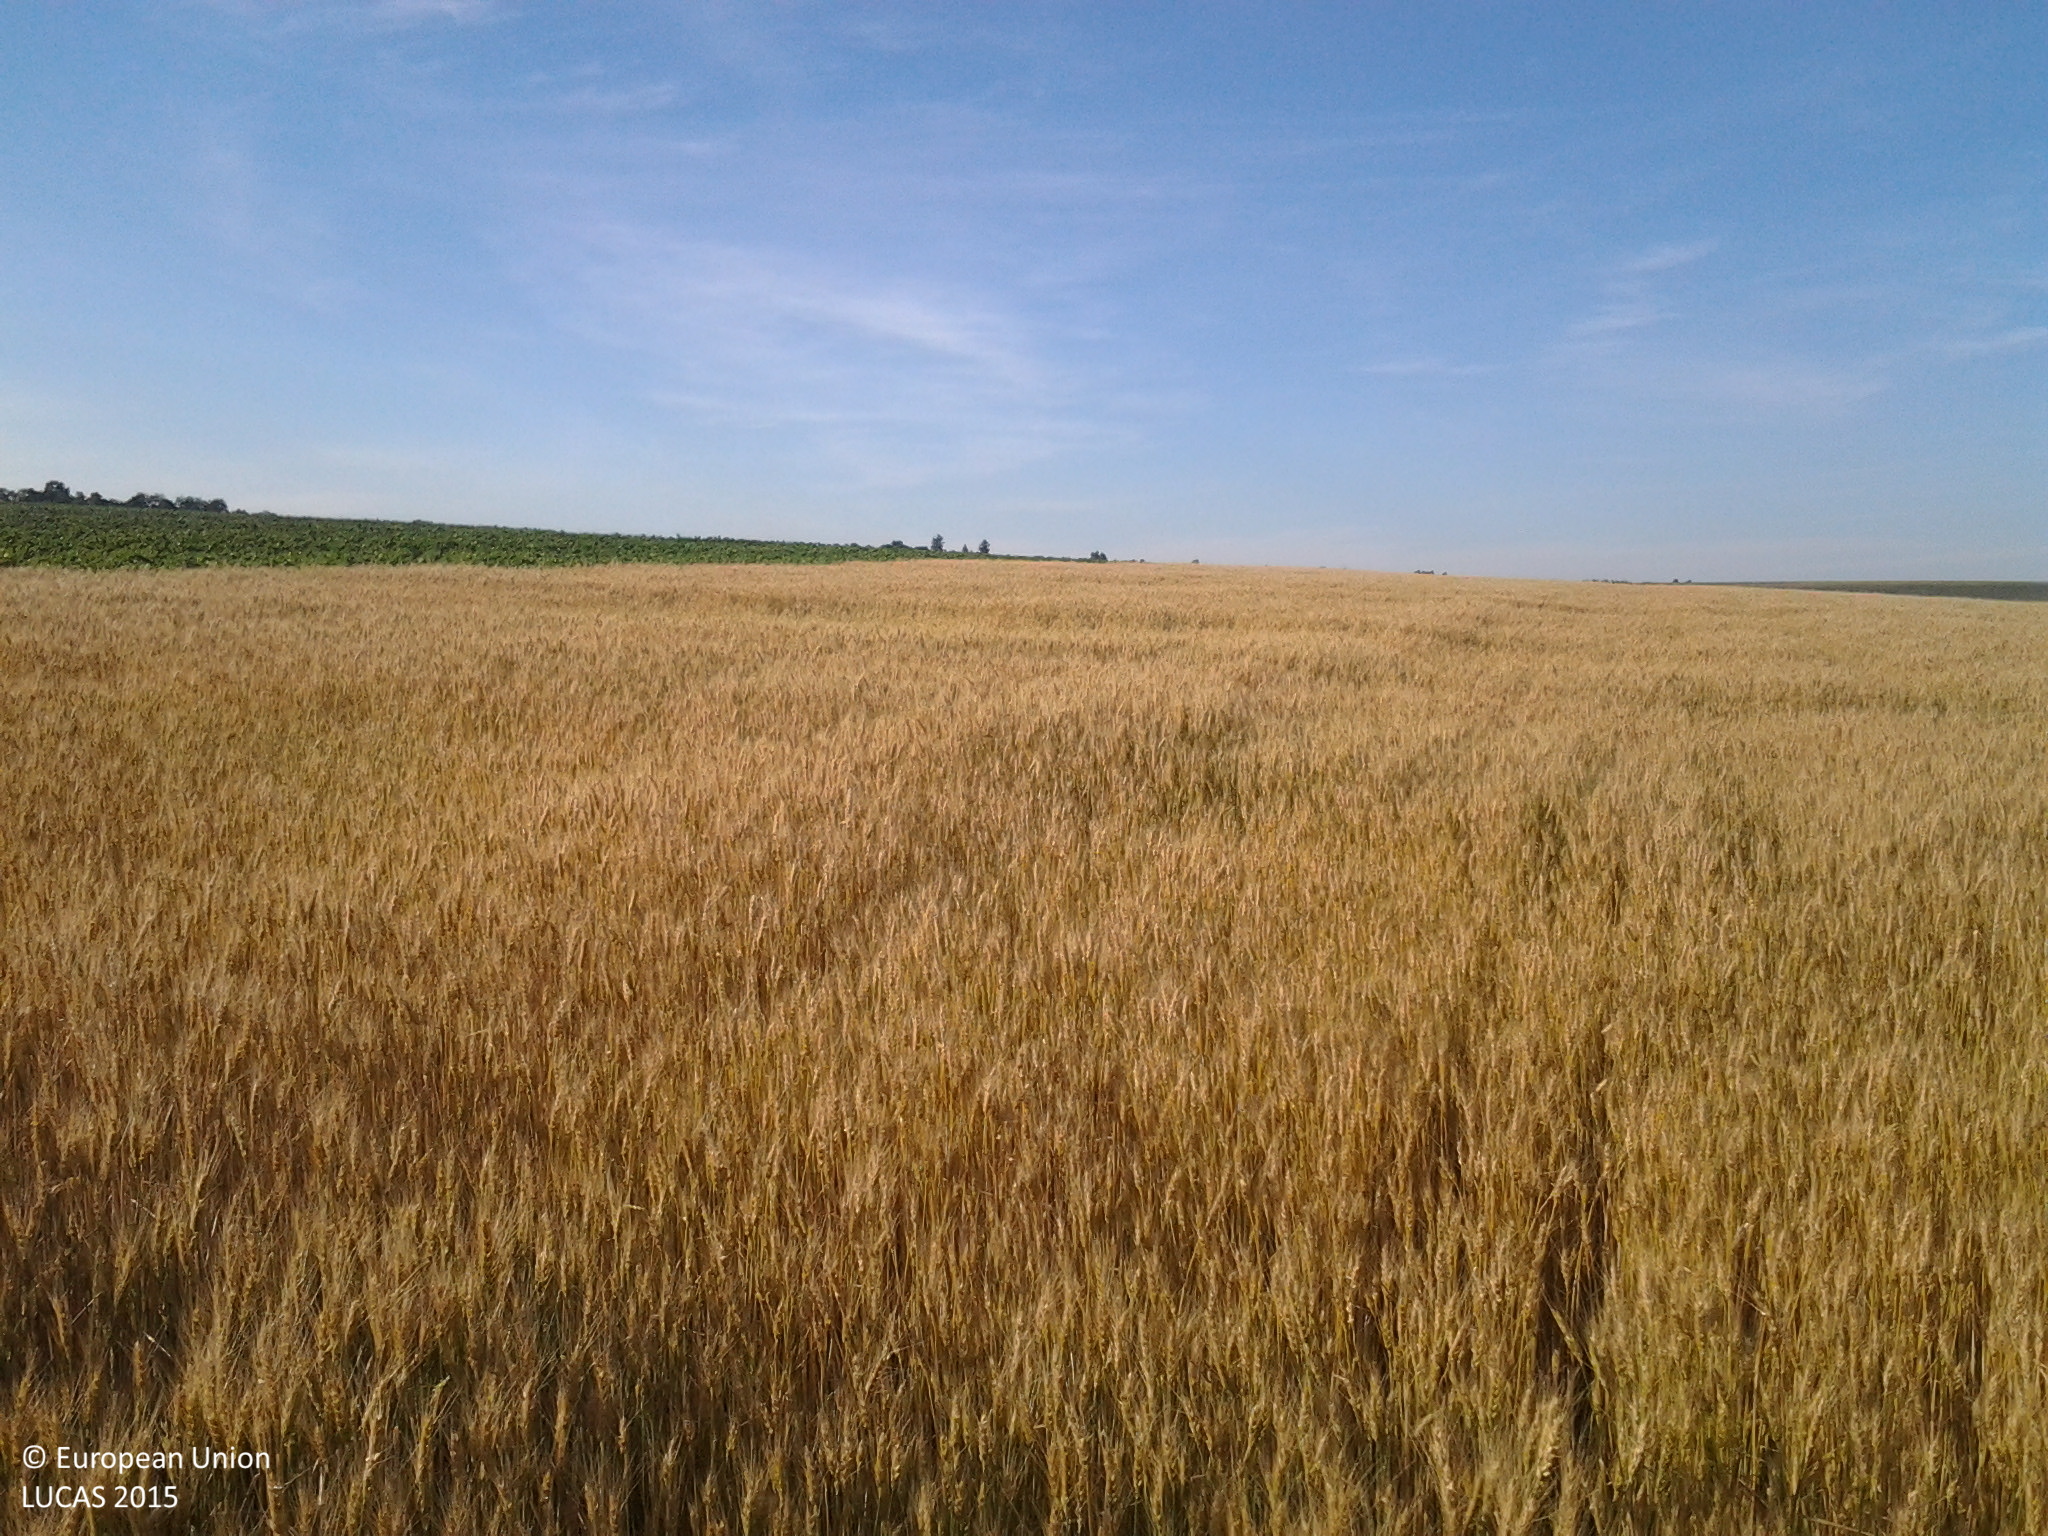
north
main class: Cropland
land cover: Durum wheat
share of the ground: > 75 %
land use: Agriculture (excluding fallow land and kitchen gardens)
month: June
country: RO
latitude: 47.1689
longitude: 26.8648
